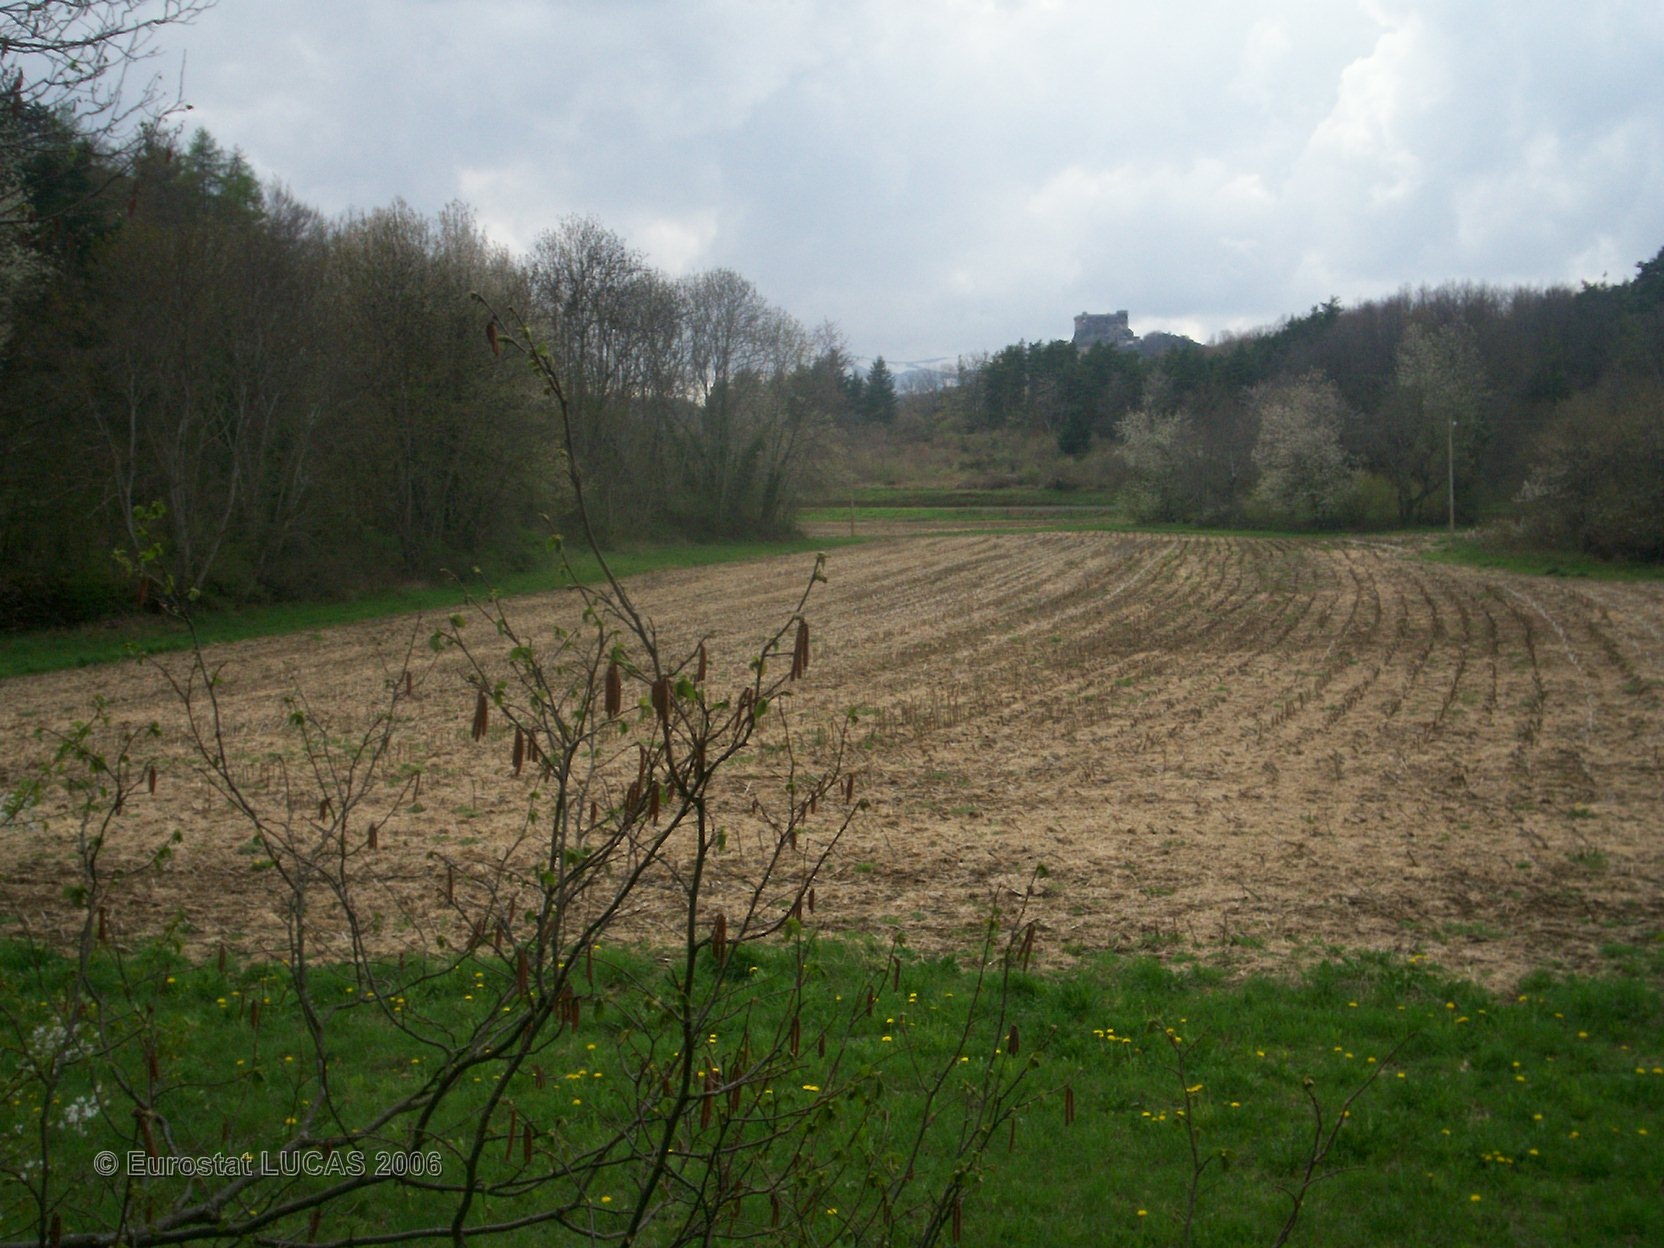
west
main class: Woodland
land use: Unused
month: April
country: FR
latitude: 45.5770
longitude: 2.9644
